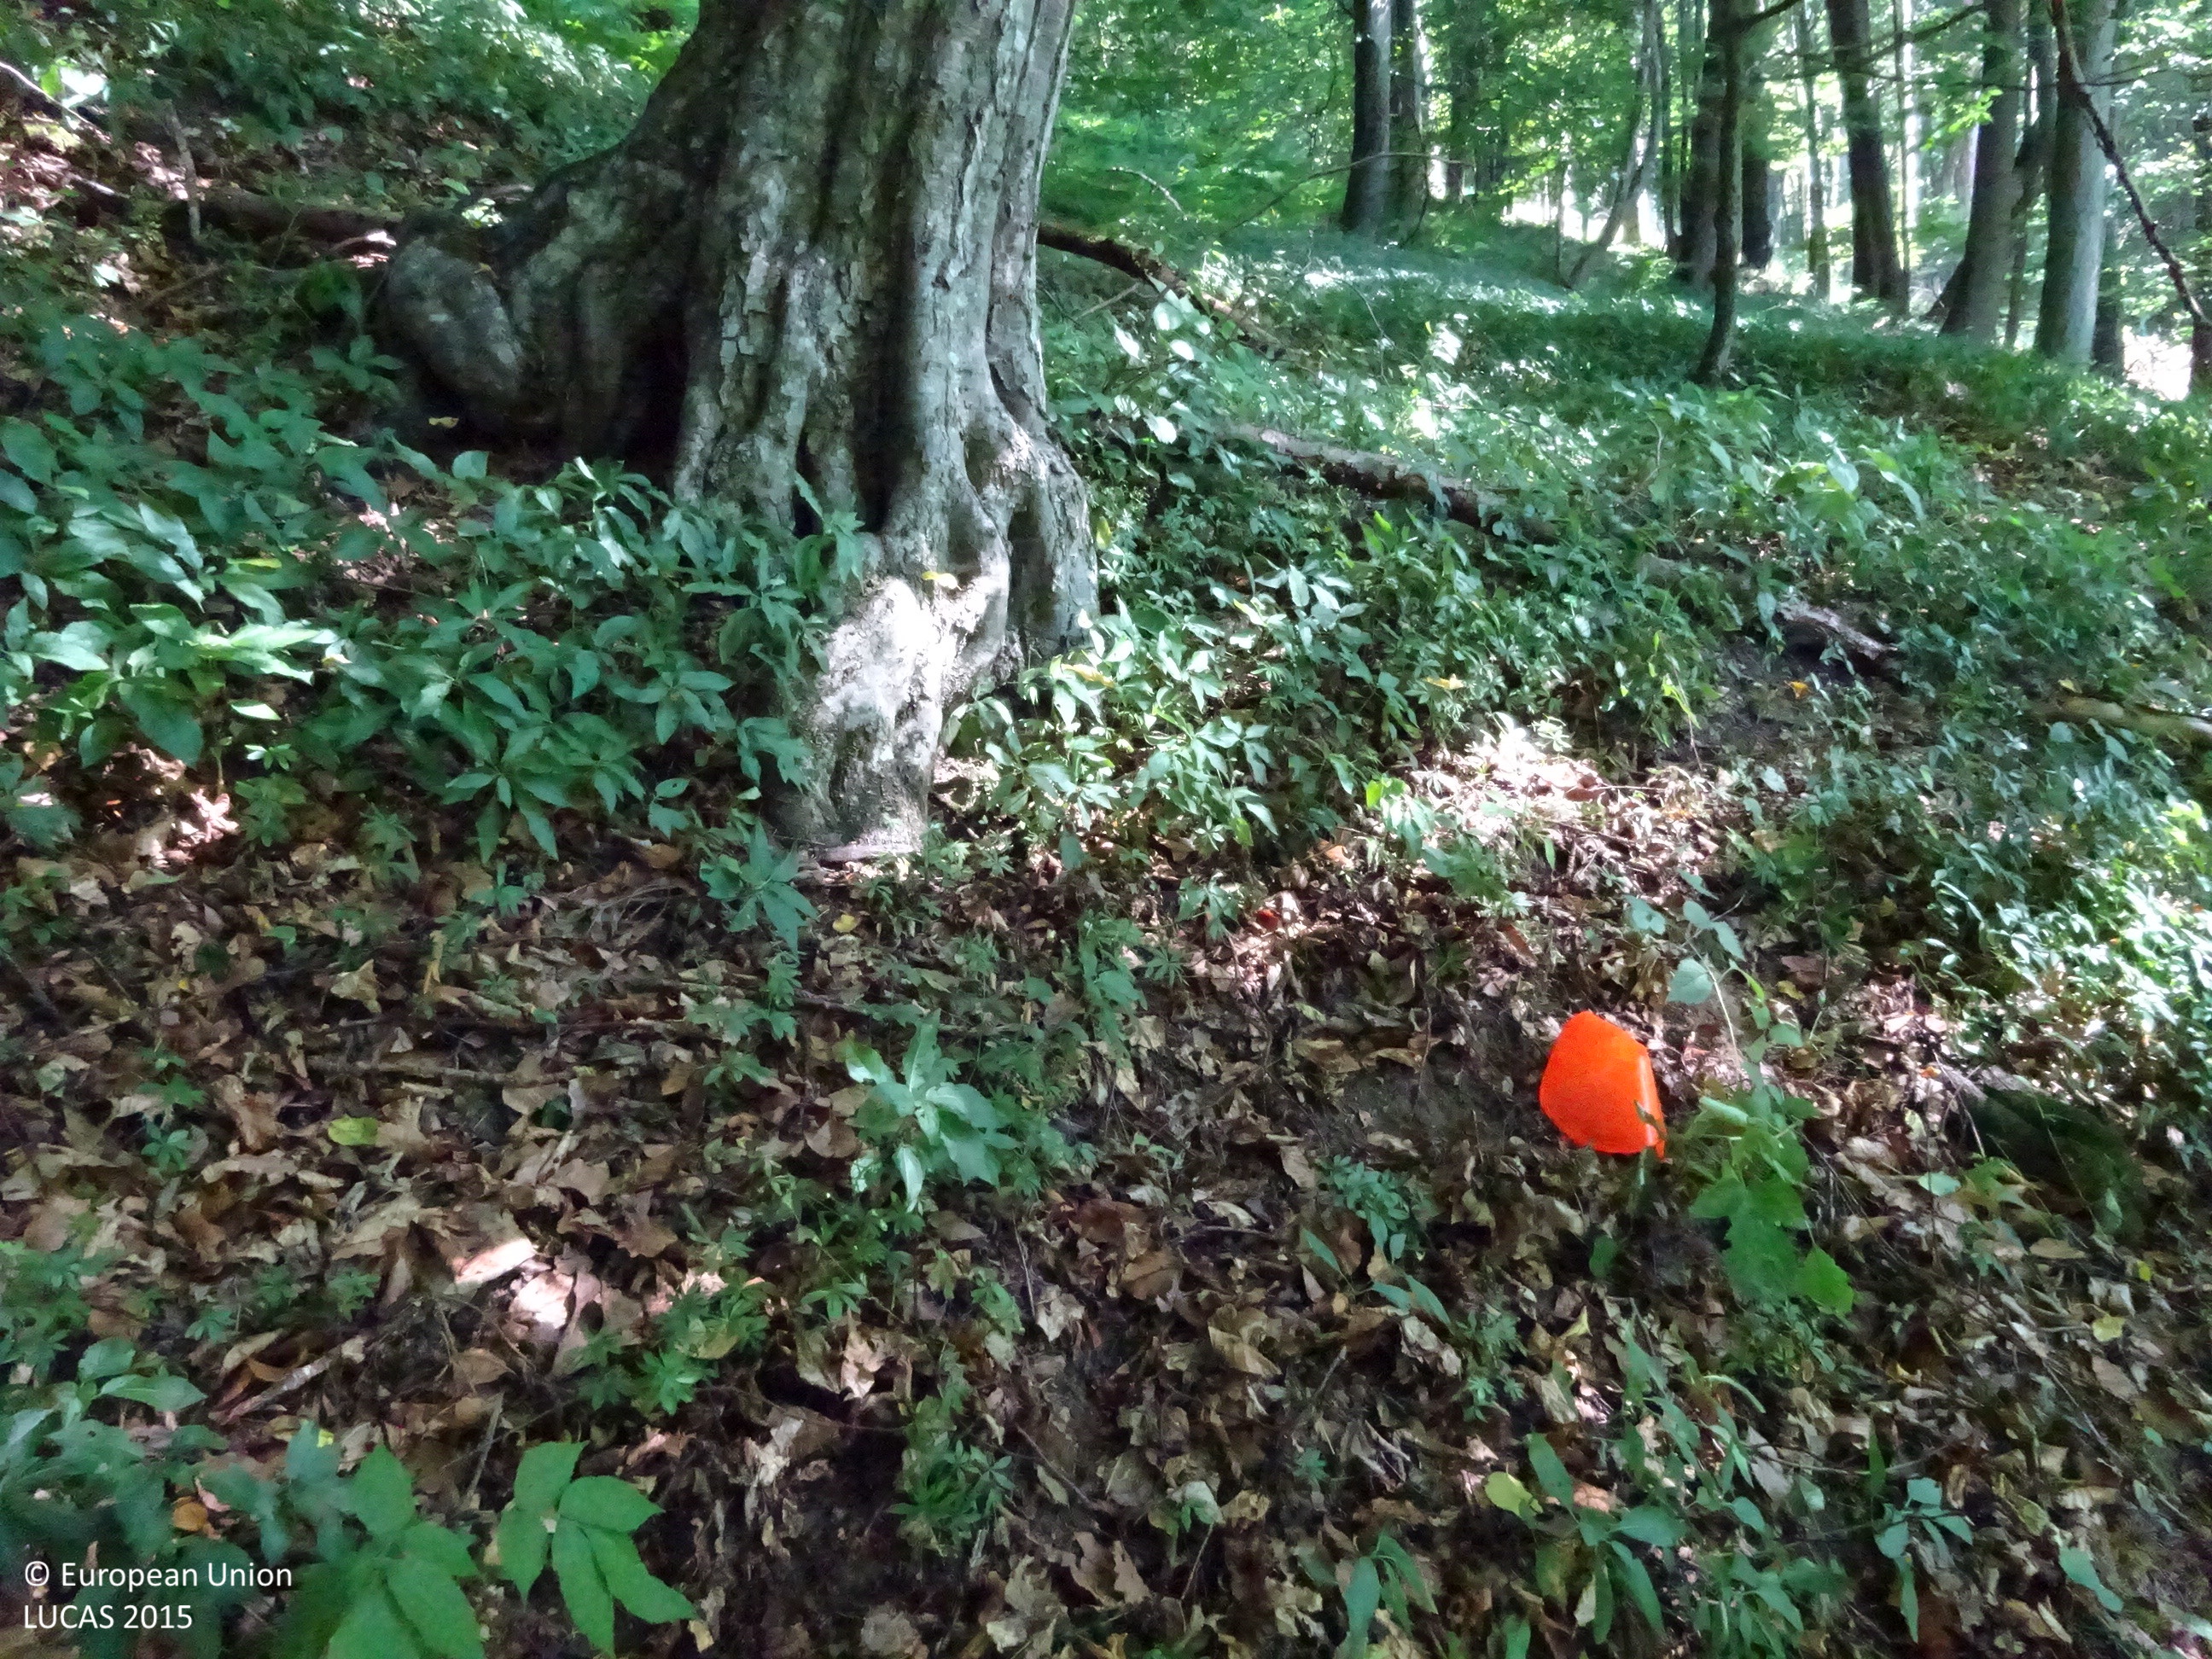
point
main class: Woodland
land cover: Broadleaved woodland
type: beech forest
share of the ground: > 75 %
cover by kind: broadleaved forest trees 100 %
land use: Forestry
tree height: > 5 m
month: August
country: AT
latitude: 47.4401
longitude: 16.1153
